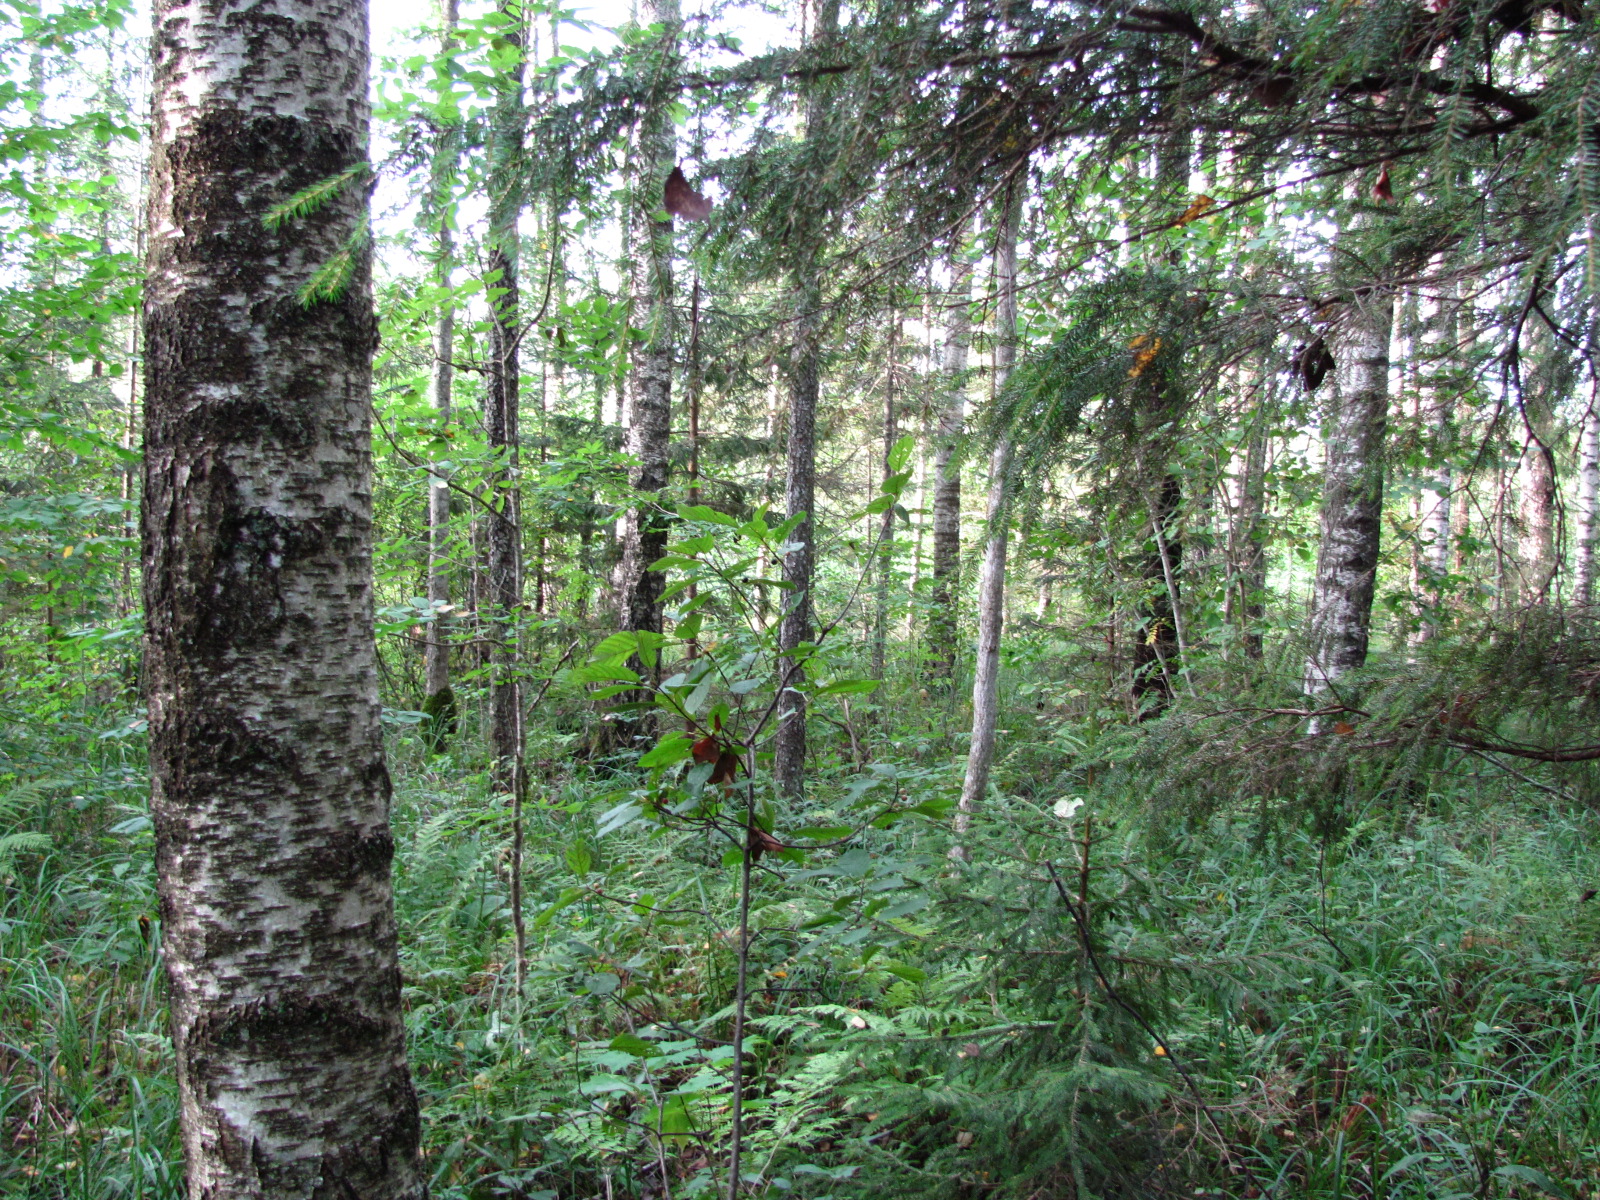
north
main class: Woodland
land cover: Spruce dominated mixed woodland
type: hemiboreal forest and nemoral coniferous forest and mixed broadleaved-coniferous forest
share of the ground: > 75 %
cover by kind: coniferous forest trees 40 %, broadleaved forest trees 40 %, herbaceous plants 10 %, lichens and mosses 10 %
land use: Forestry
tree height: > 5 m
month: September
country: LV
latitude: 56.7027
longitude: 25.2198
